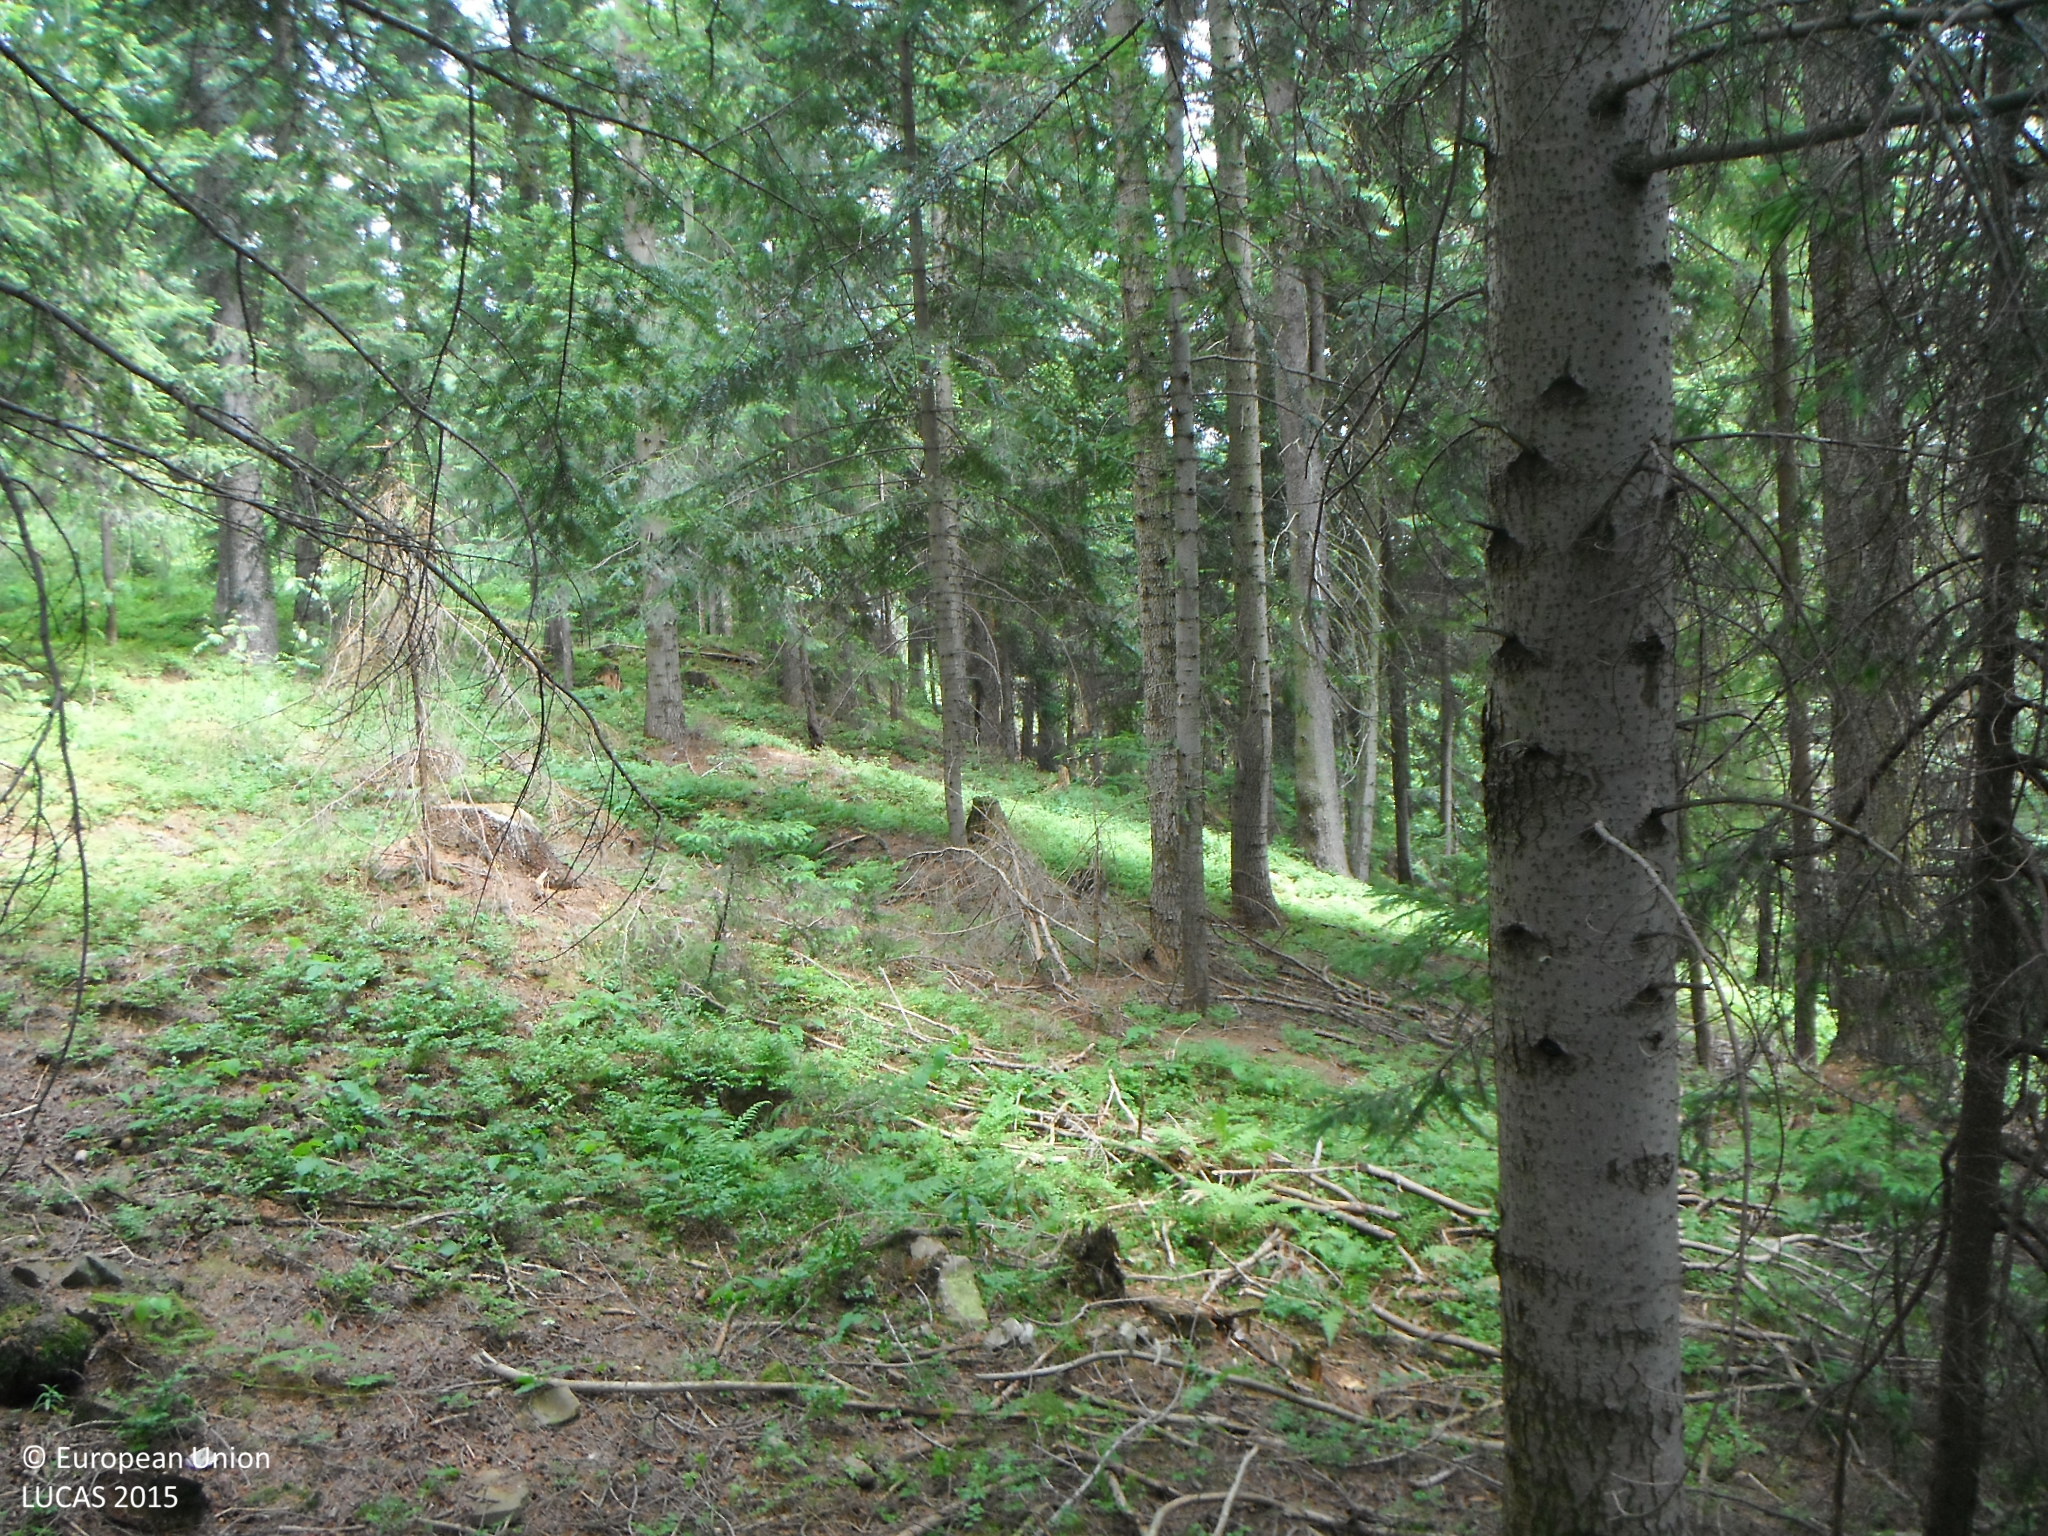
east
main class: Woodland
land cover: Spruce dominated coniferous woodland
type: alpine coniferous forest
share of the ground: > 75 %
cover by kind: coniferous forest trees 95 %, herbaceous plants 5 %
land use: Forestry
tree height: > 5 m
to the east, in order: Spruce dominated coniferous woodland; Spontaneously vegetated surfaces; Other coniferous woodland; Spruce dominated coniferous woodland; Spruce dominated mixed woodland
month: July
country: SK
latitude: 49.5115
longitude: 19.5430
